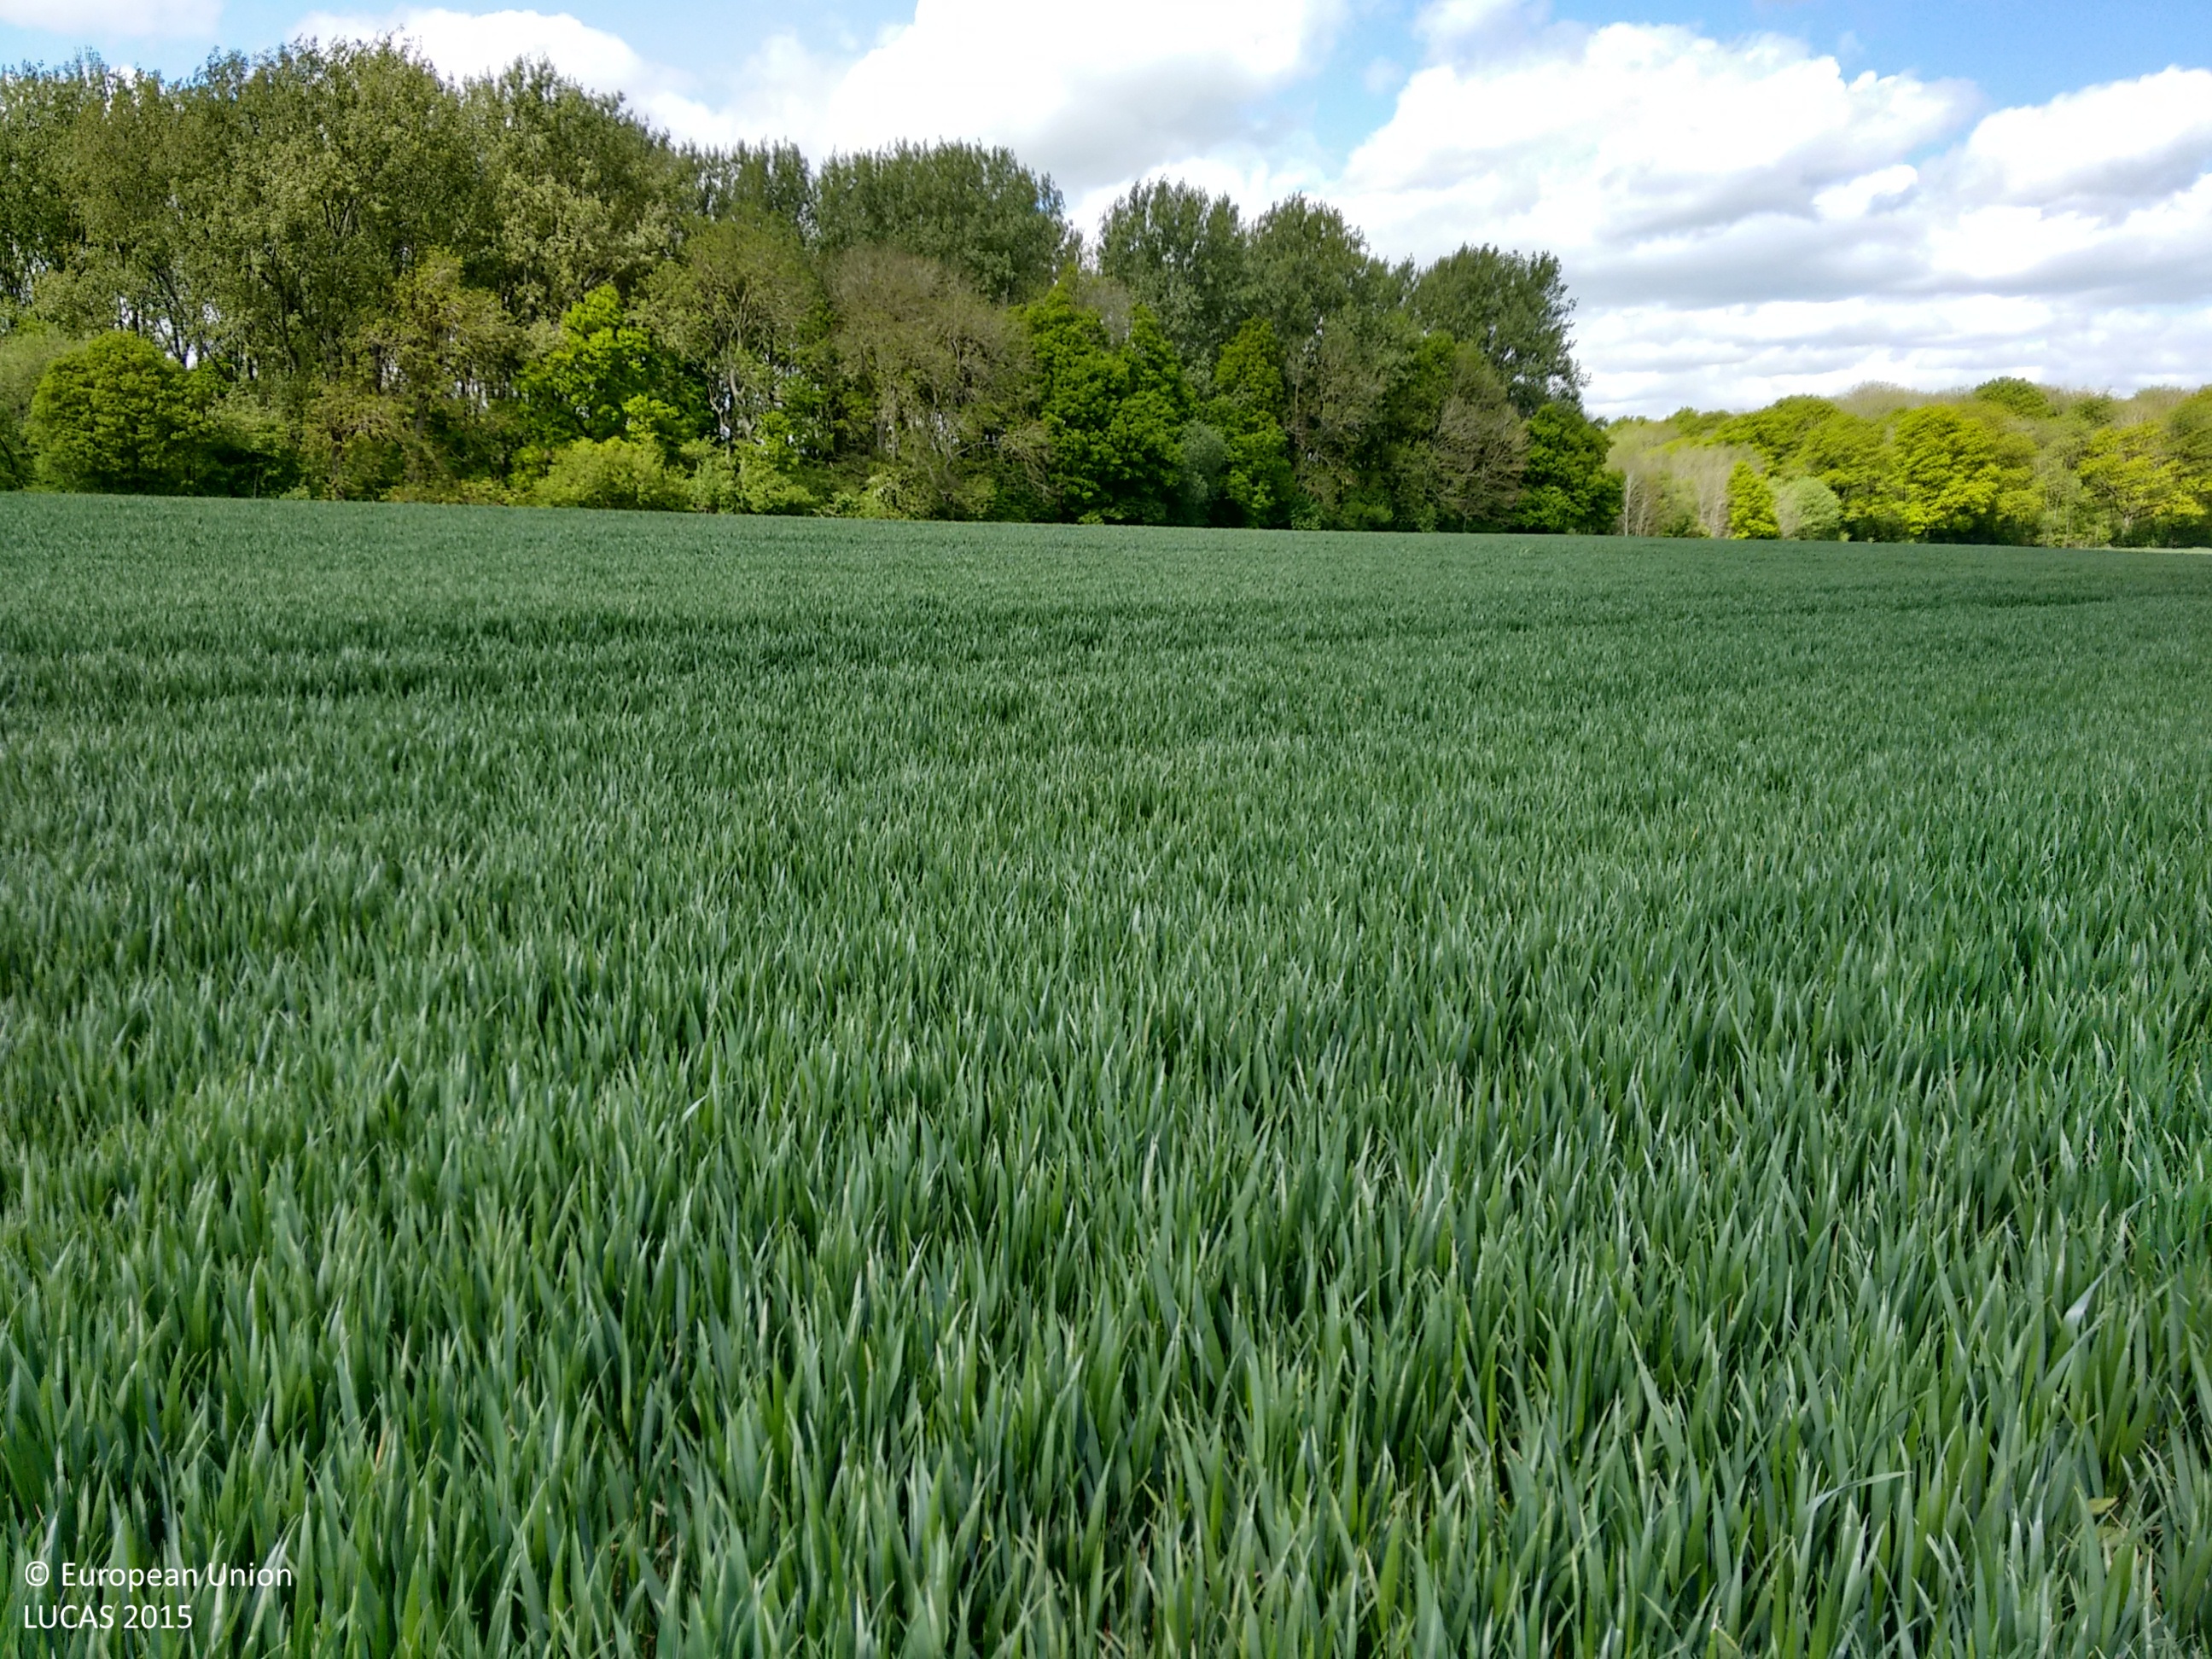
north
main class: Cropland
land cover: Common wheat
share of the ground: > 75 %
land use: Agriculture (excluding fallow land and kitchen gardens)
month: May
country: GB
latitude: 51.3194
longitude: -1.1960
